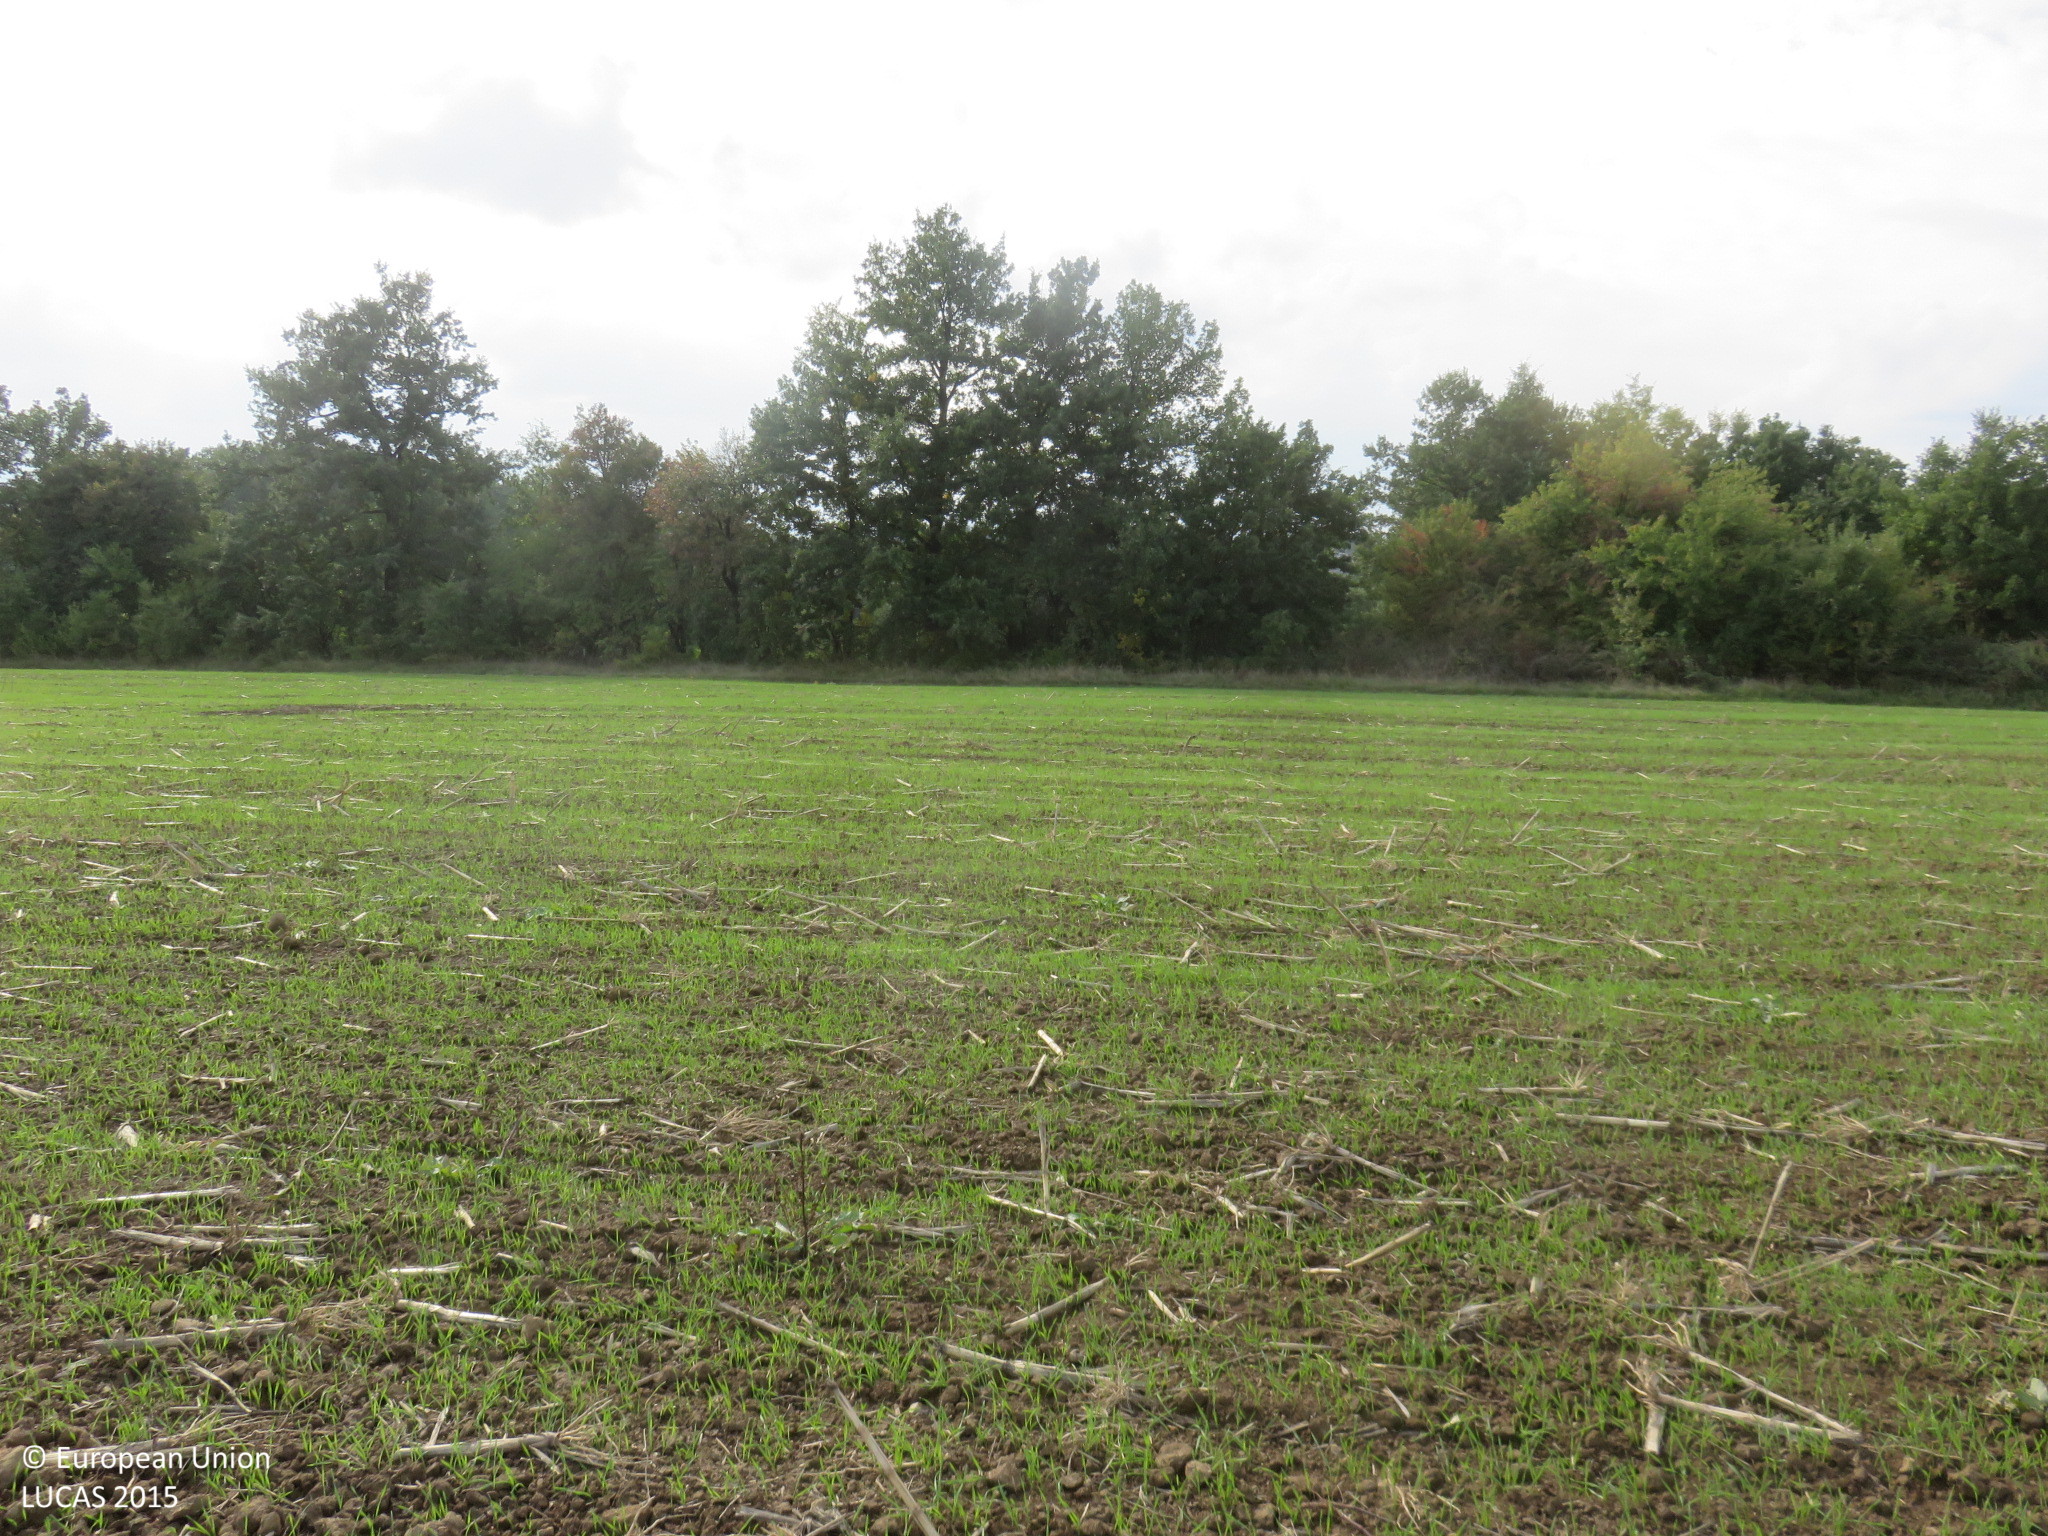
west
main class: Cropland
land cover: Maize
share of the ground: < 10 %
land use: Agriculture (excluding fallow land and kitchen gardens)
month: October
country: BG
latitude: 42.9392
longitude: 25.3788
